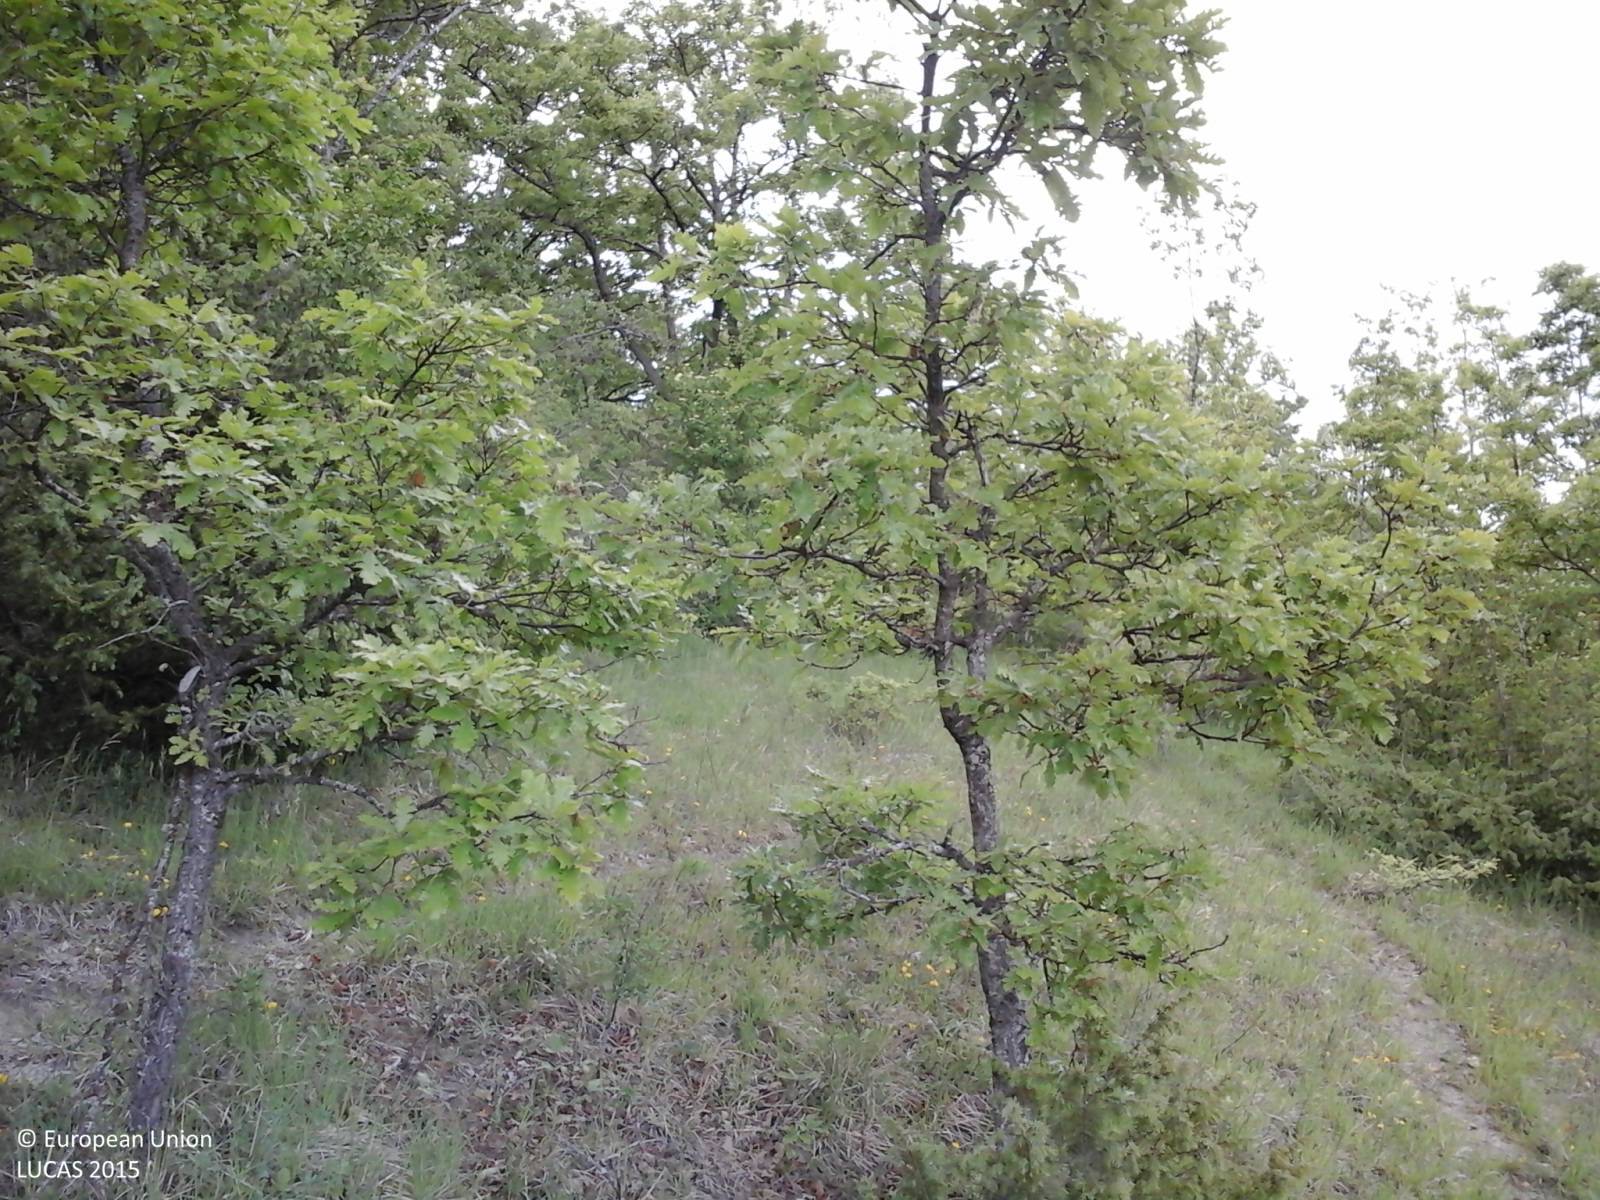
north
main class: Woodland
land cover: Broadleaved woodland
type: thermophilous deciduous forest
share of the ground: 10 - 25 %
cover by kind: herbaceous plants 80 %, broadleaved forest trees 10 %, shrubs 10 %
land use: Agriculture (excluding fallow land and kitchen gardens)
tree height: < 5 m
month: May
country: IT
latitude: 41.8439
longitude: 14.1889
